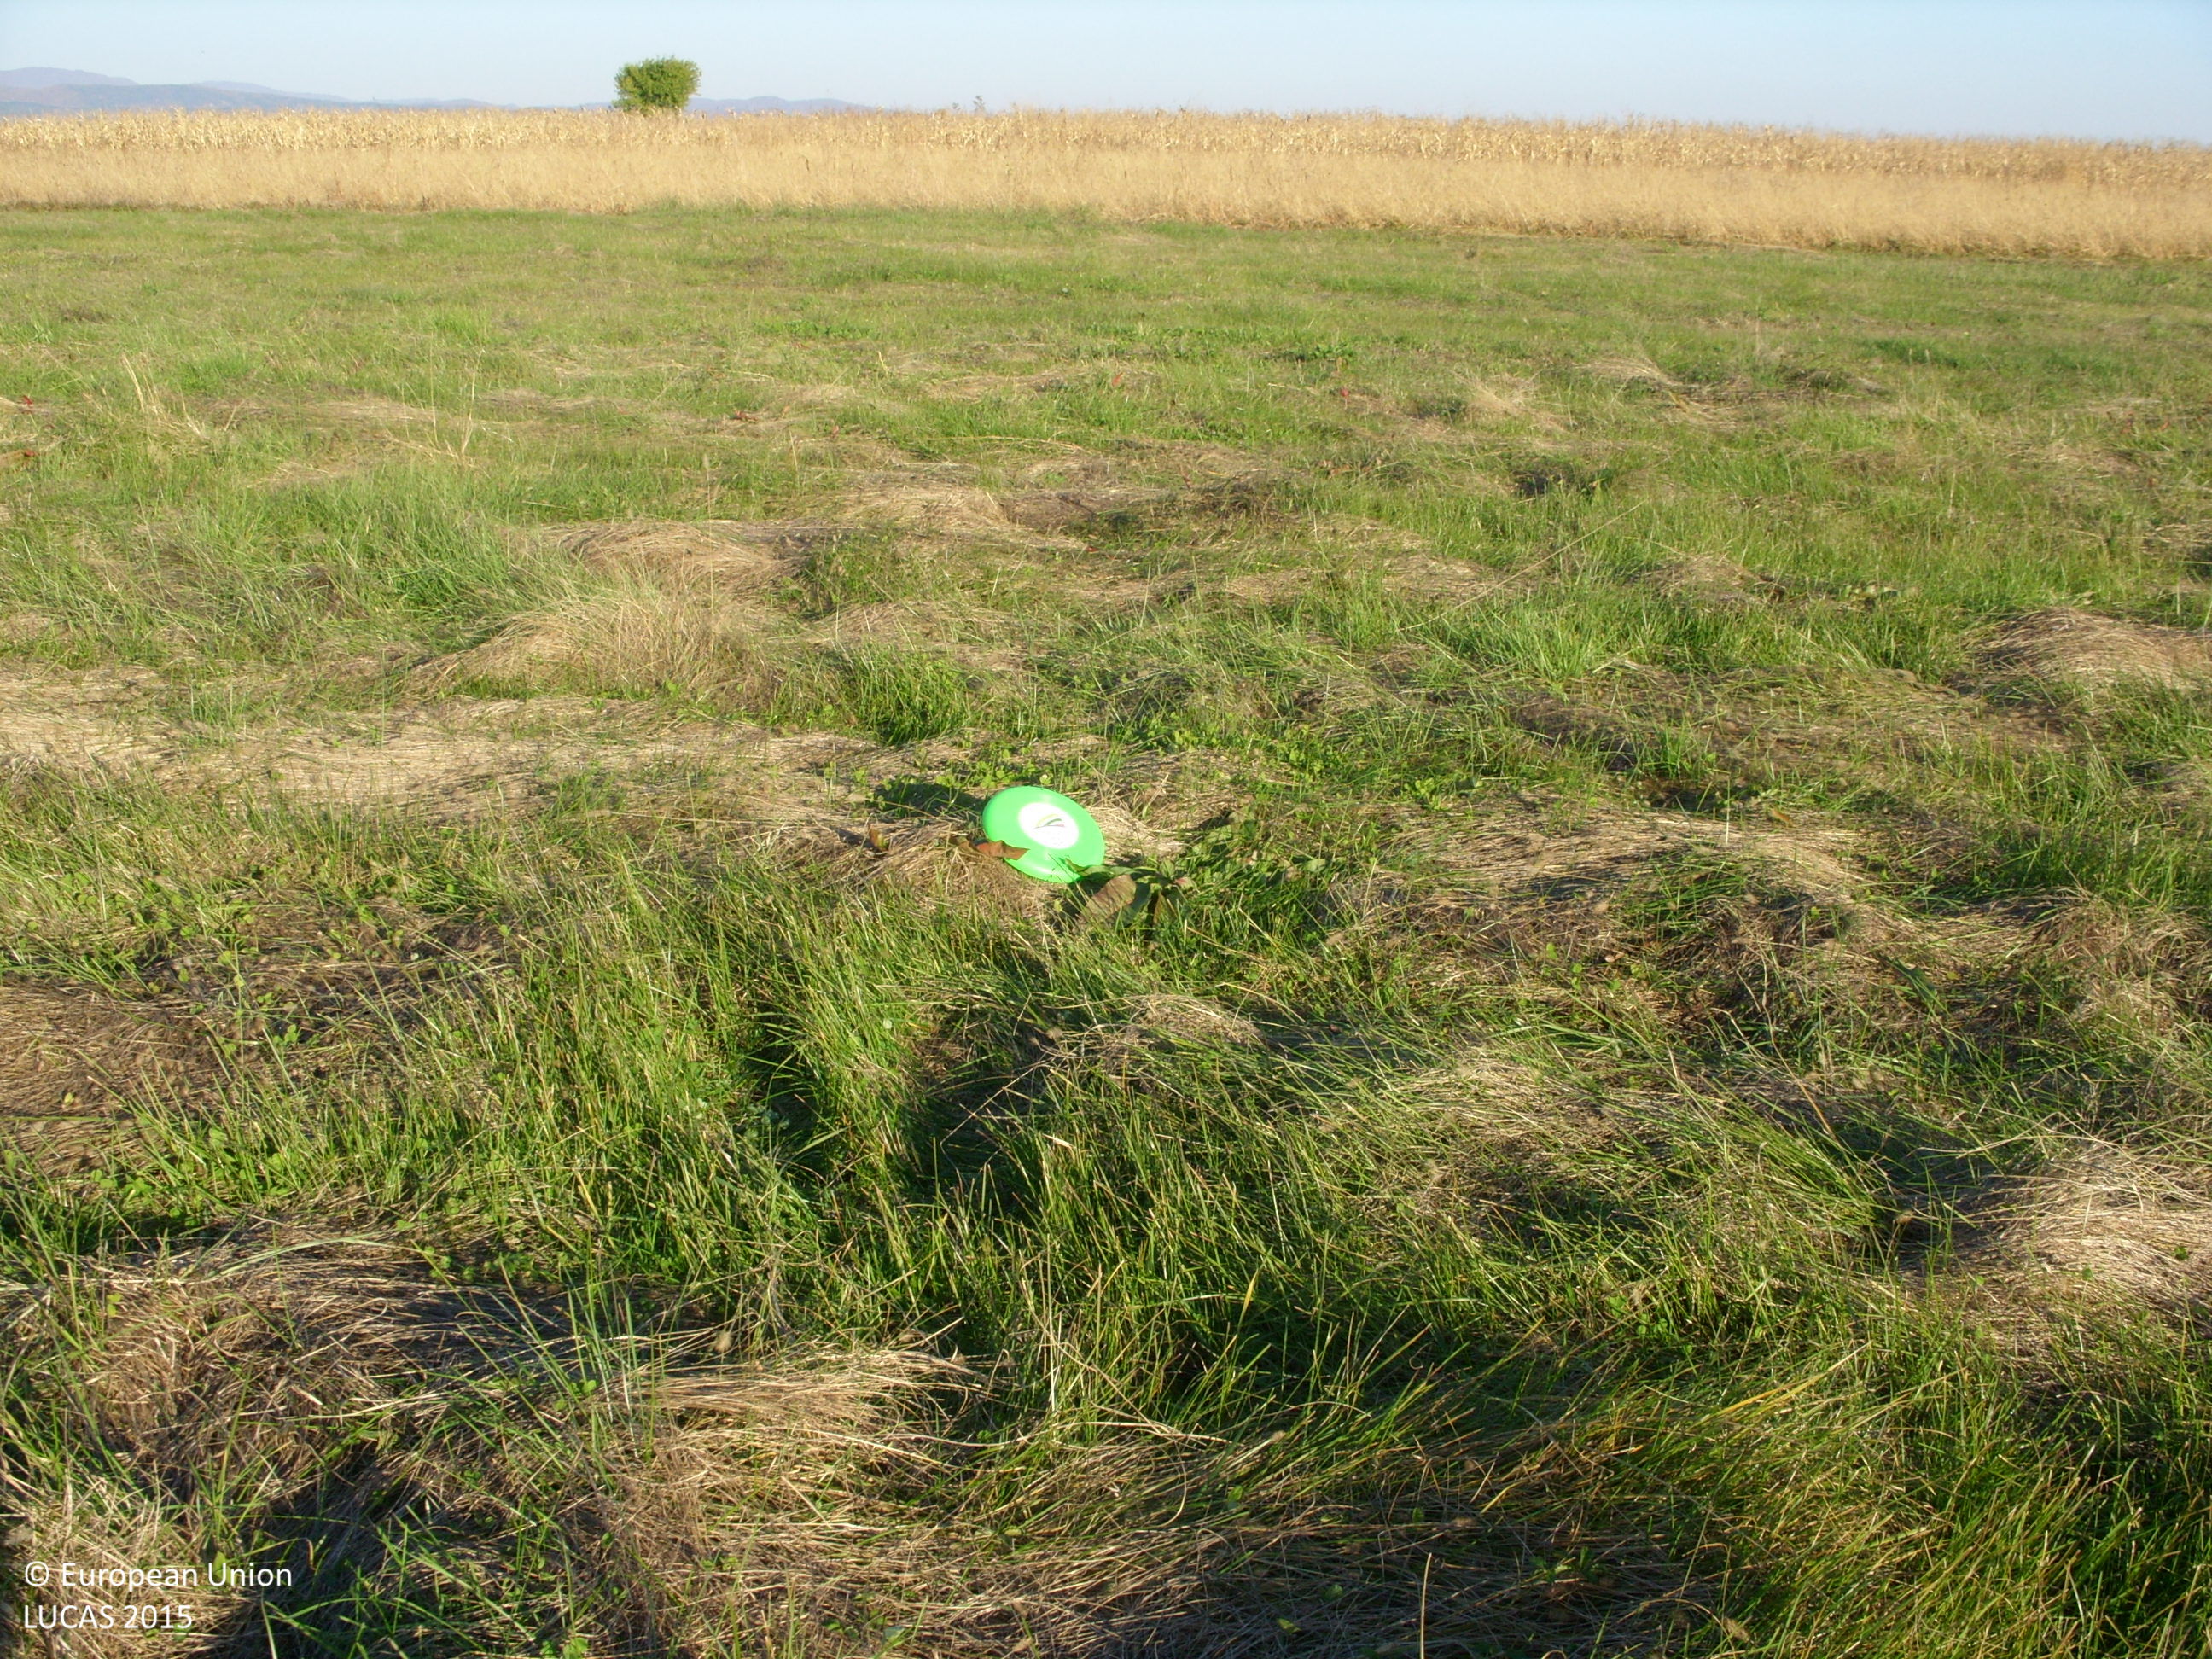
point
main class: Grassland
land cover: Grassland without tree/shrub cover
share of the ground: > 75 %
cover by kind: herbaceous plants 100 %
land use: Agriculture (excluding fallow land and kitchen gardens)
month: November
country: BG
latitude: 42.4110
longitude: 24.8692
